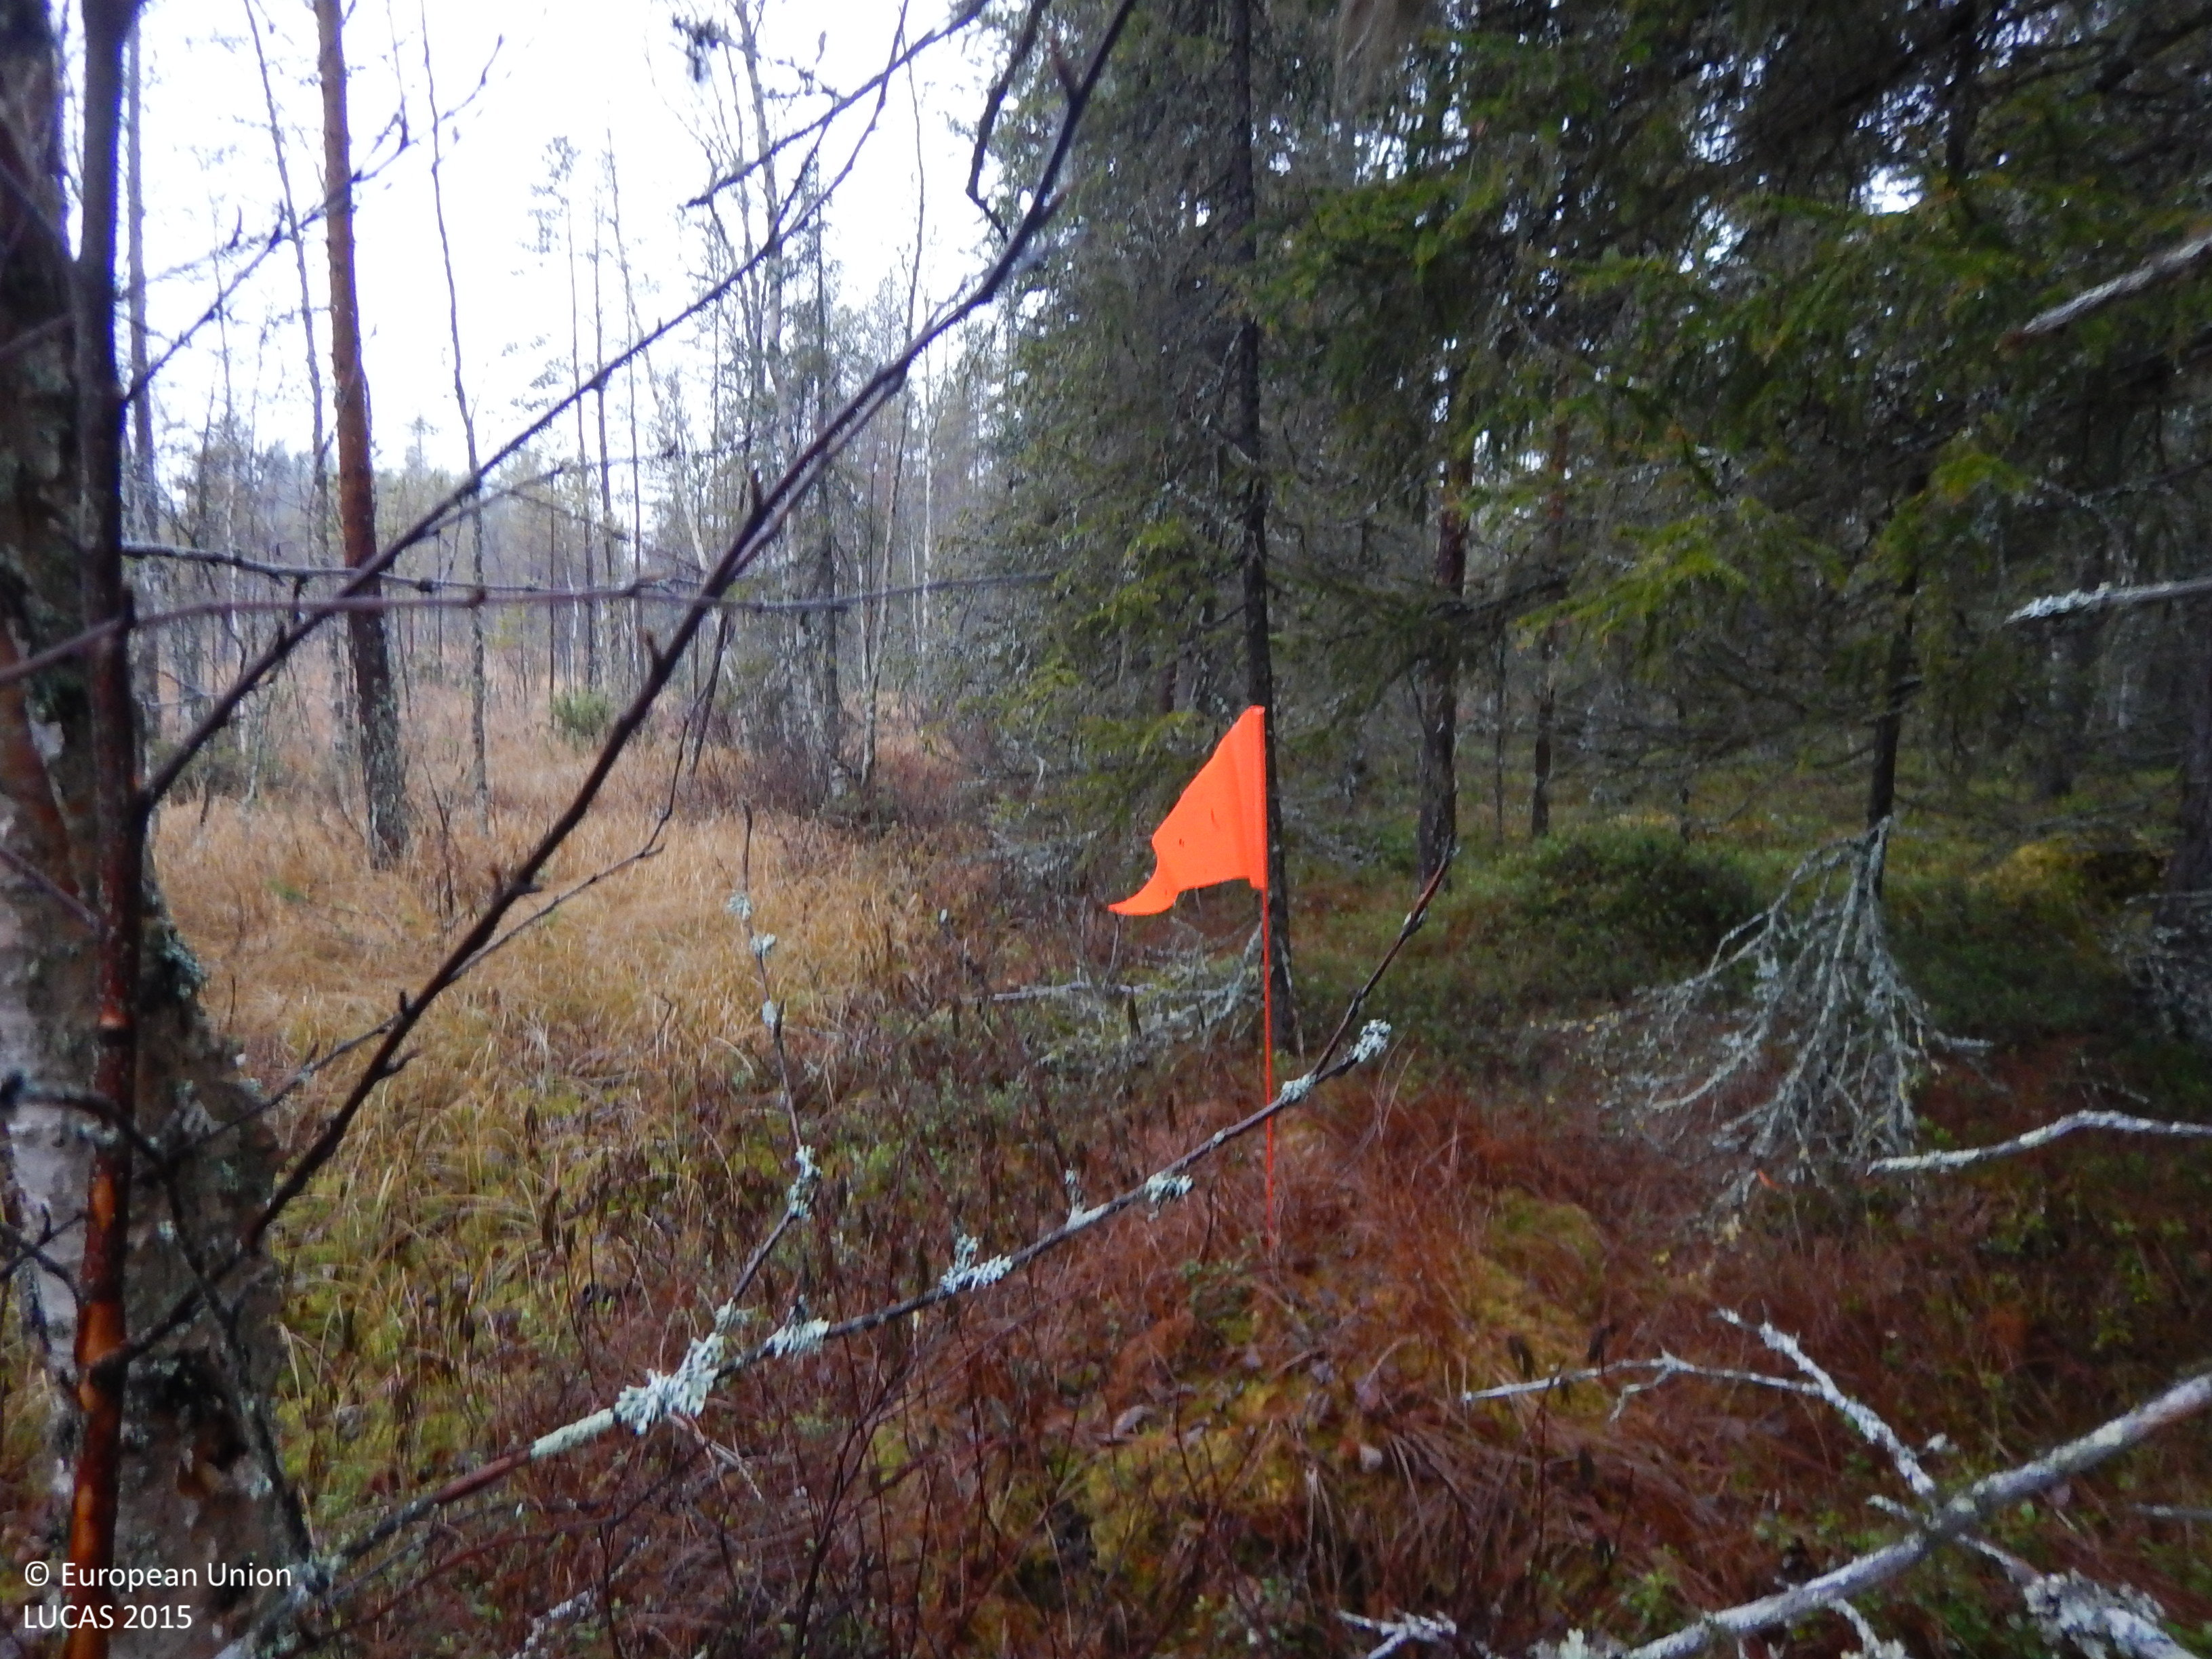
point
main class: Woodland
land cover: Other mixed woodland
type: boreal forest
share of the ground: 50 - 75 %
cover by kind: coniferous forest trees 40 %, lichens and mosses 20 %, broadleaved forest trees 15 %, shrubs 15 %, herbaceous plants 10 %
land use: Forestry
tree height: > 5 m
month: November
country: SE
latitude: 65.1073
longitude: 20.5108
